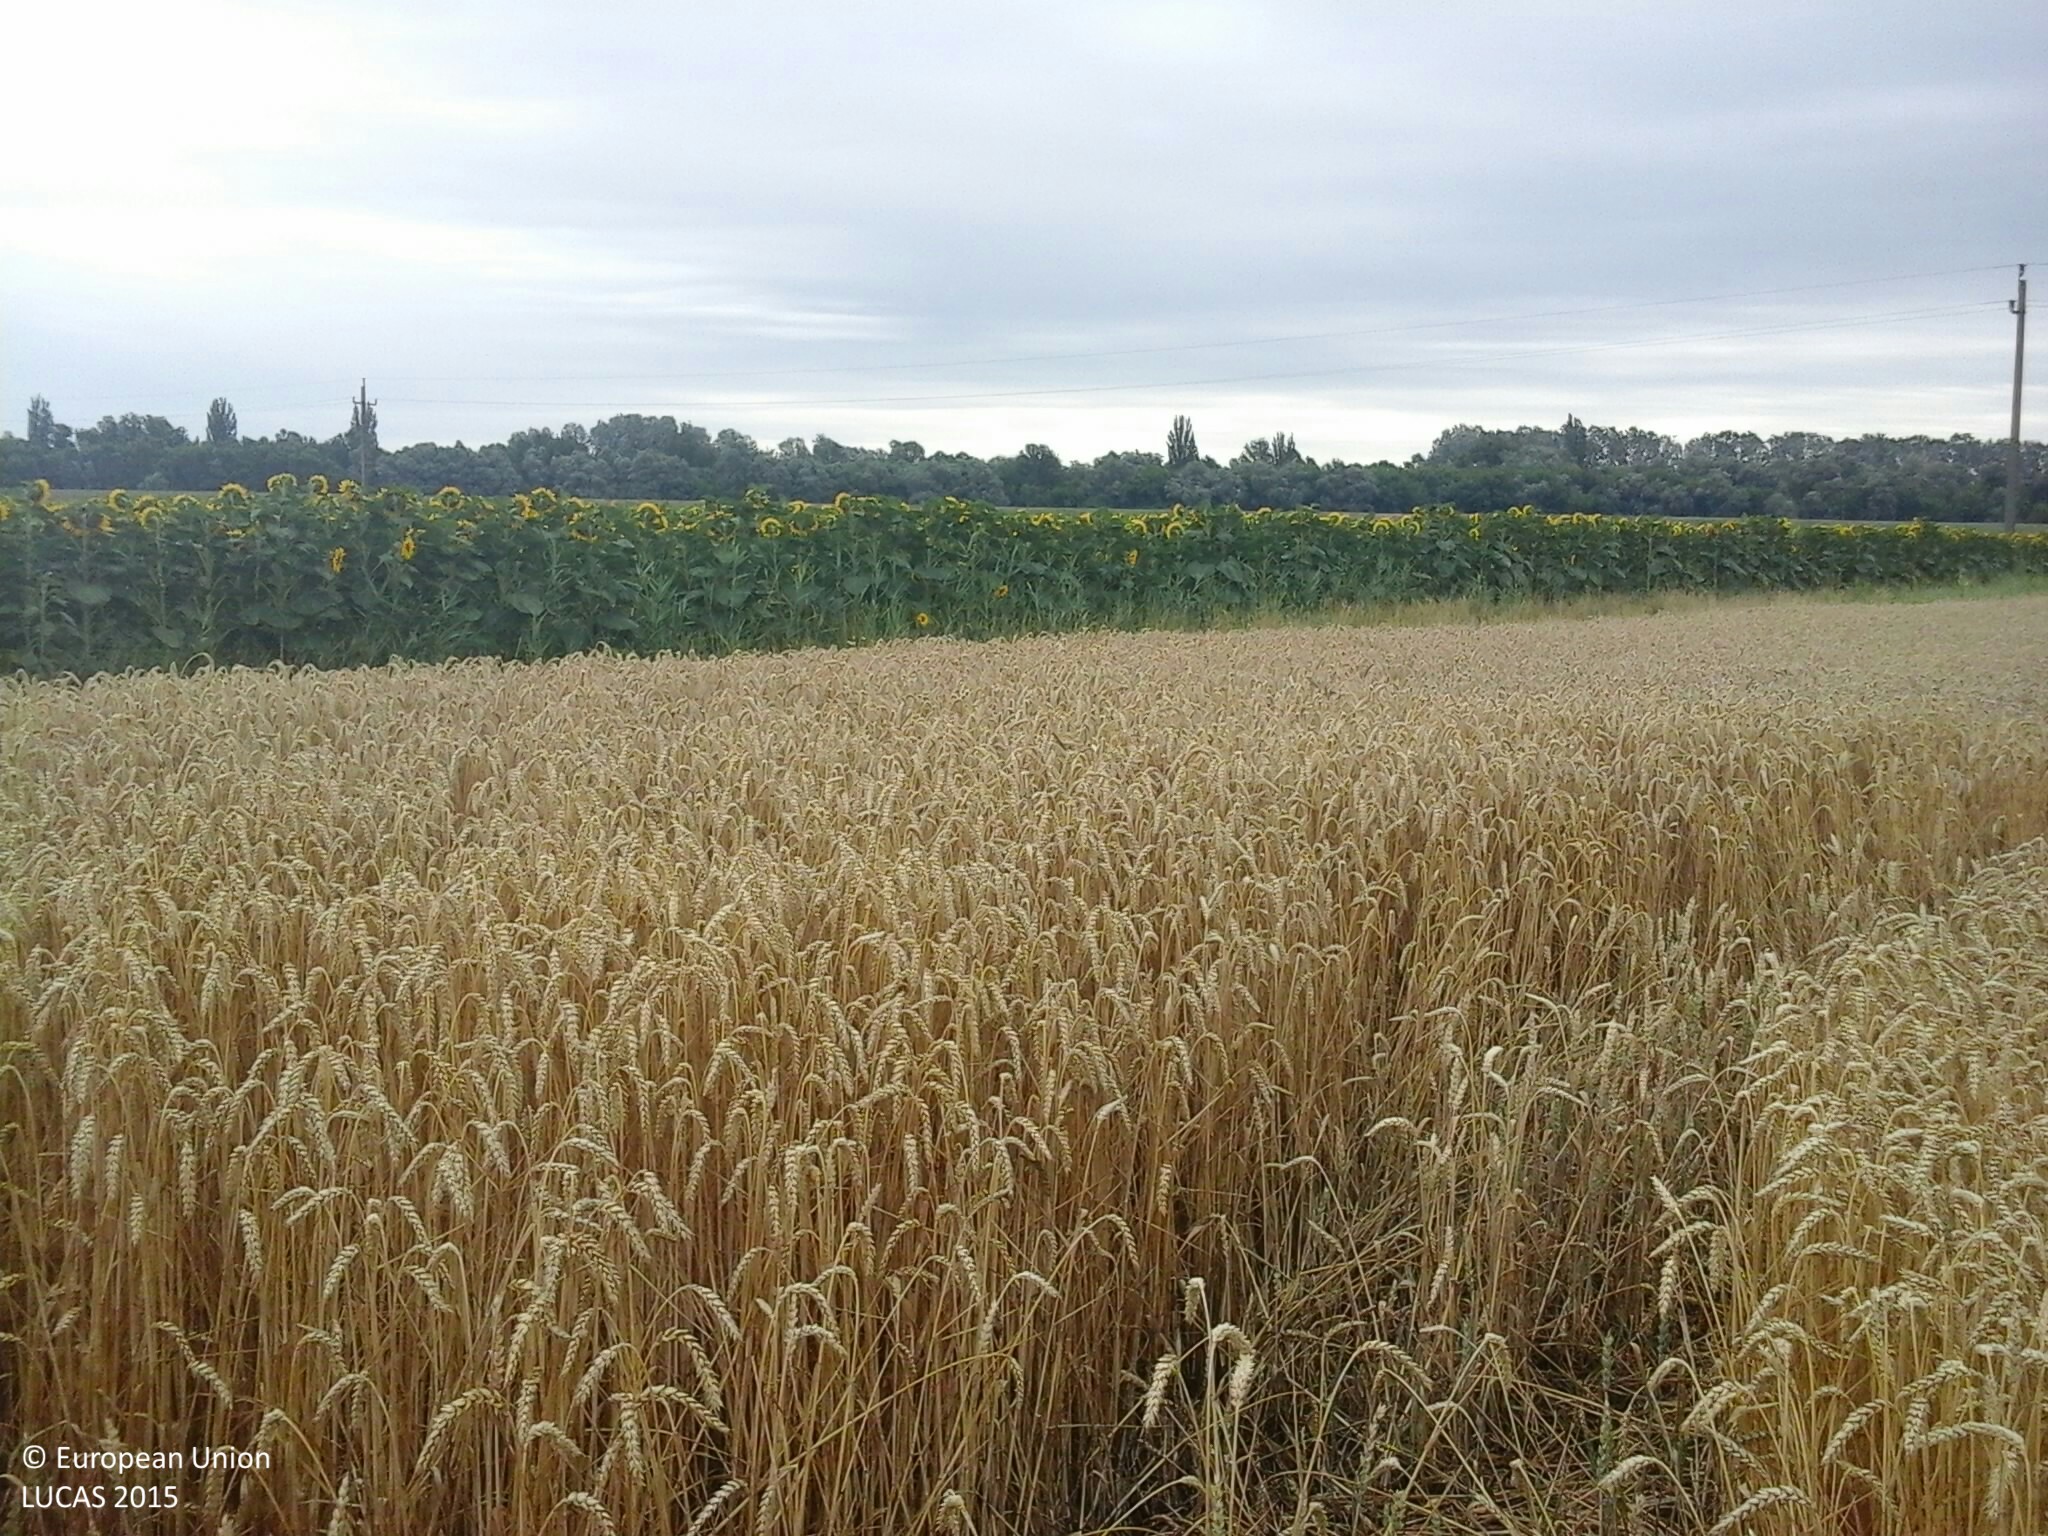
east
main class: Cropland
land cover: Common wheat
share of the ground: > 75 %
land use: Agriculture (excluding fallow land and kitchen gardens)
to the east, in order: Common wheat; Tracks; Sunflower; Electric lines; Sunflower
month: July
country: HU
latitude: 46.6450
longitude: 20.1755
